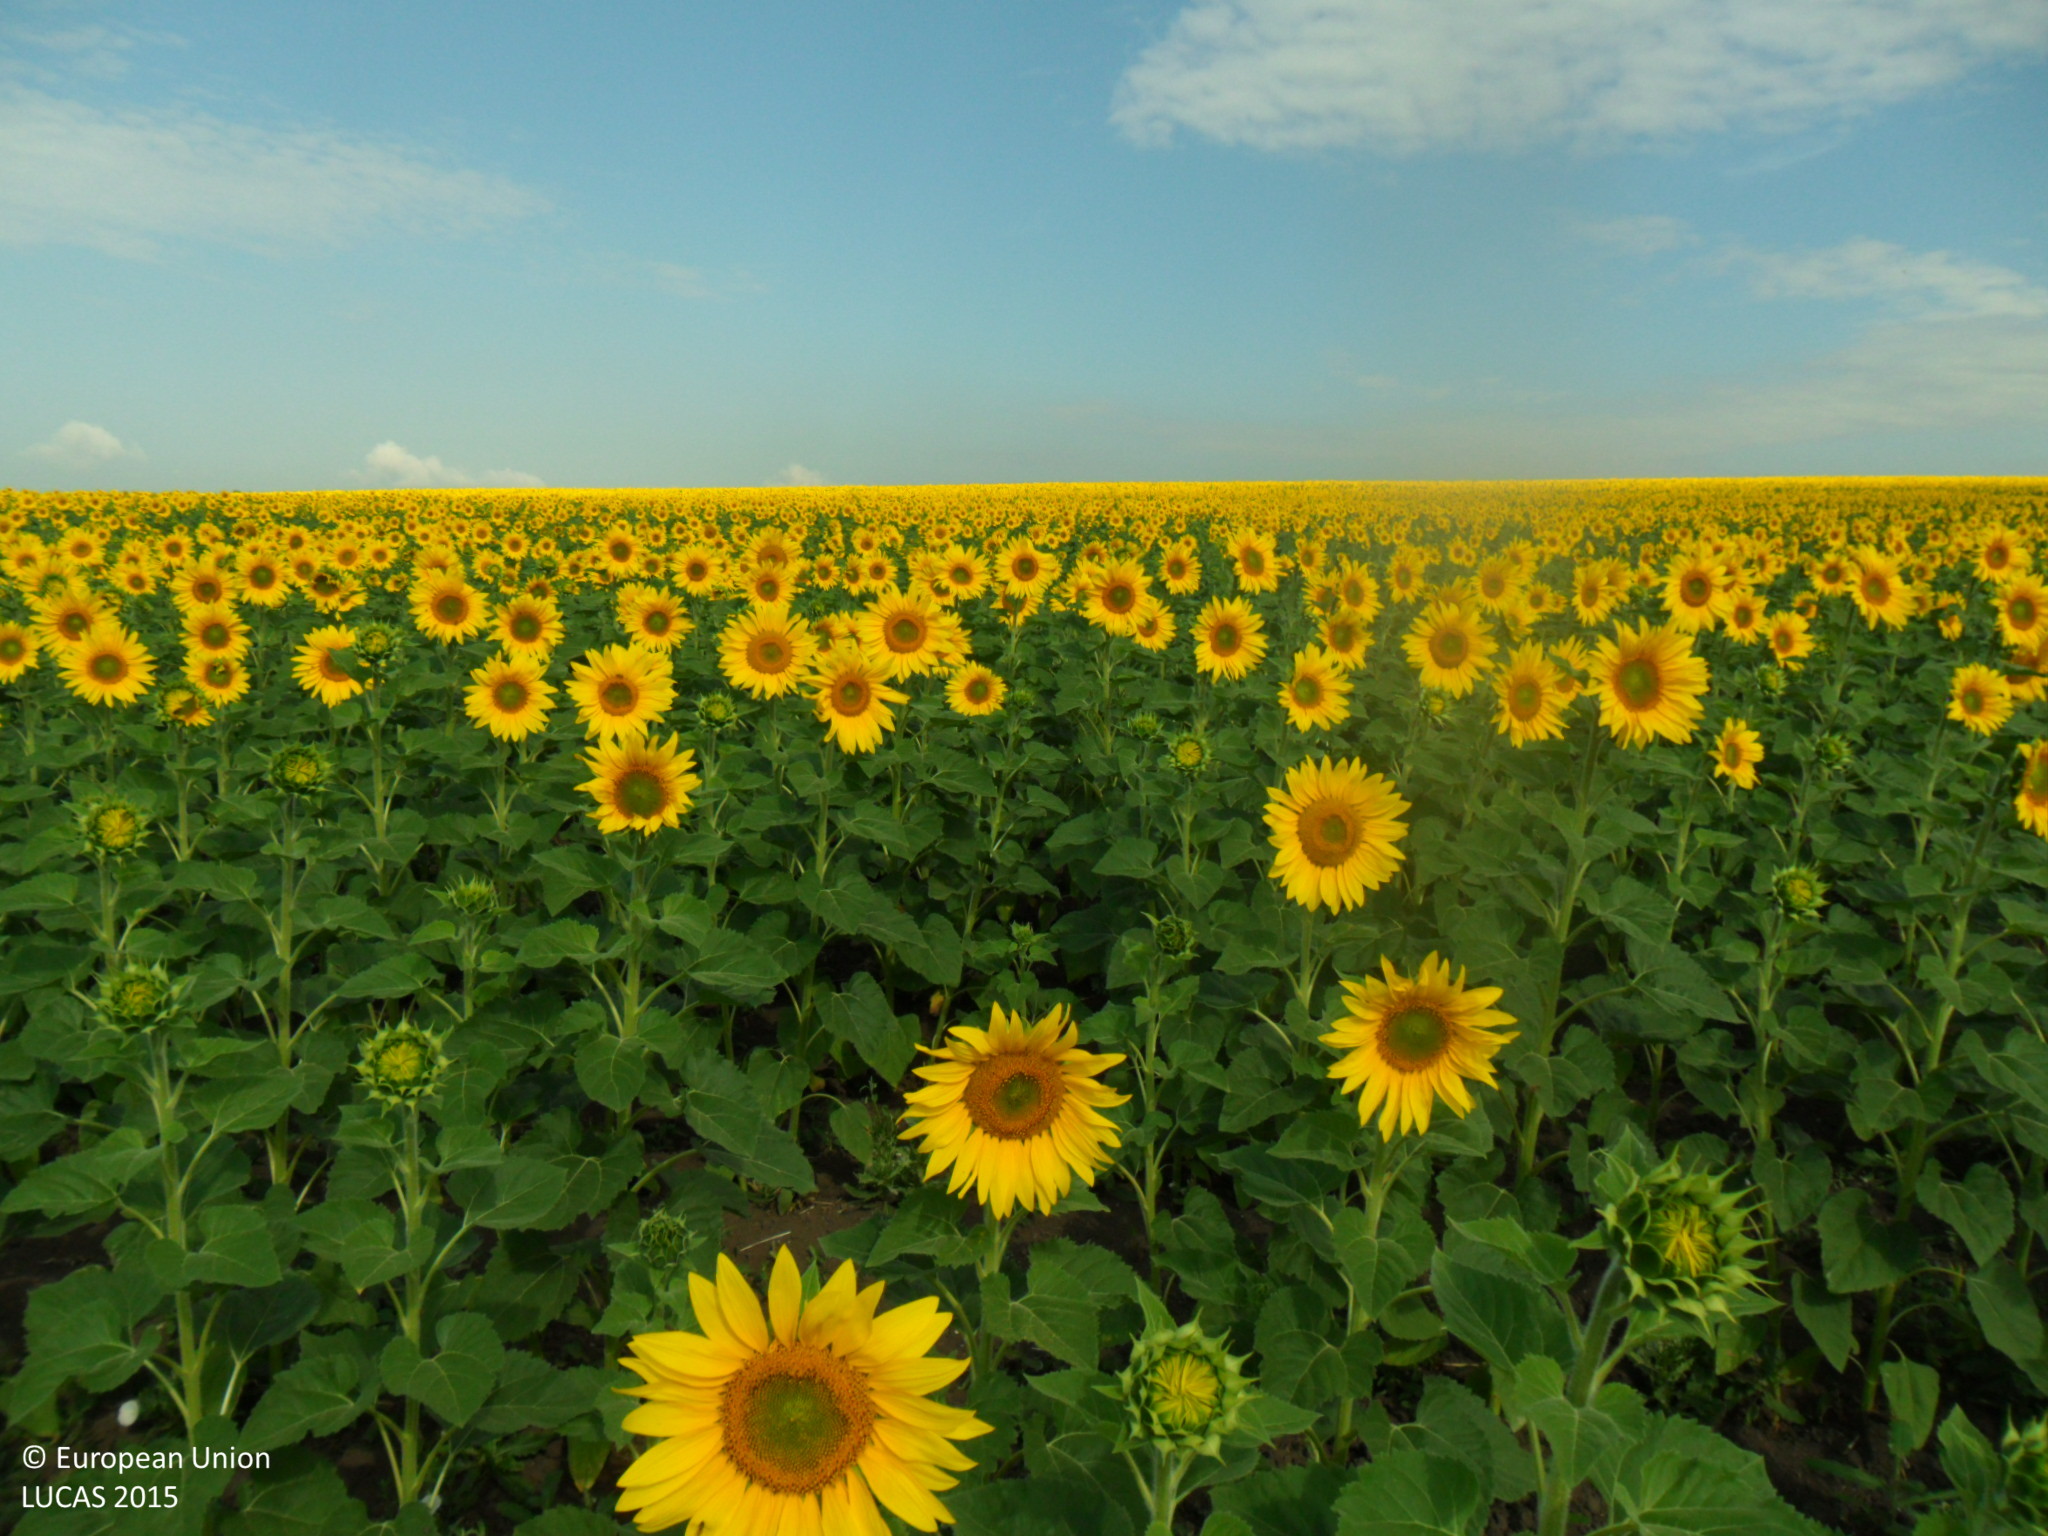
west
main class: Cropland
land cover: Sunflower
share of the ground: > 75 %
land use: Agriculture (excluding fallow land and kitchen gardens)
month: June
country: BG
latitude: 43.3721
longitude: 26.8089
